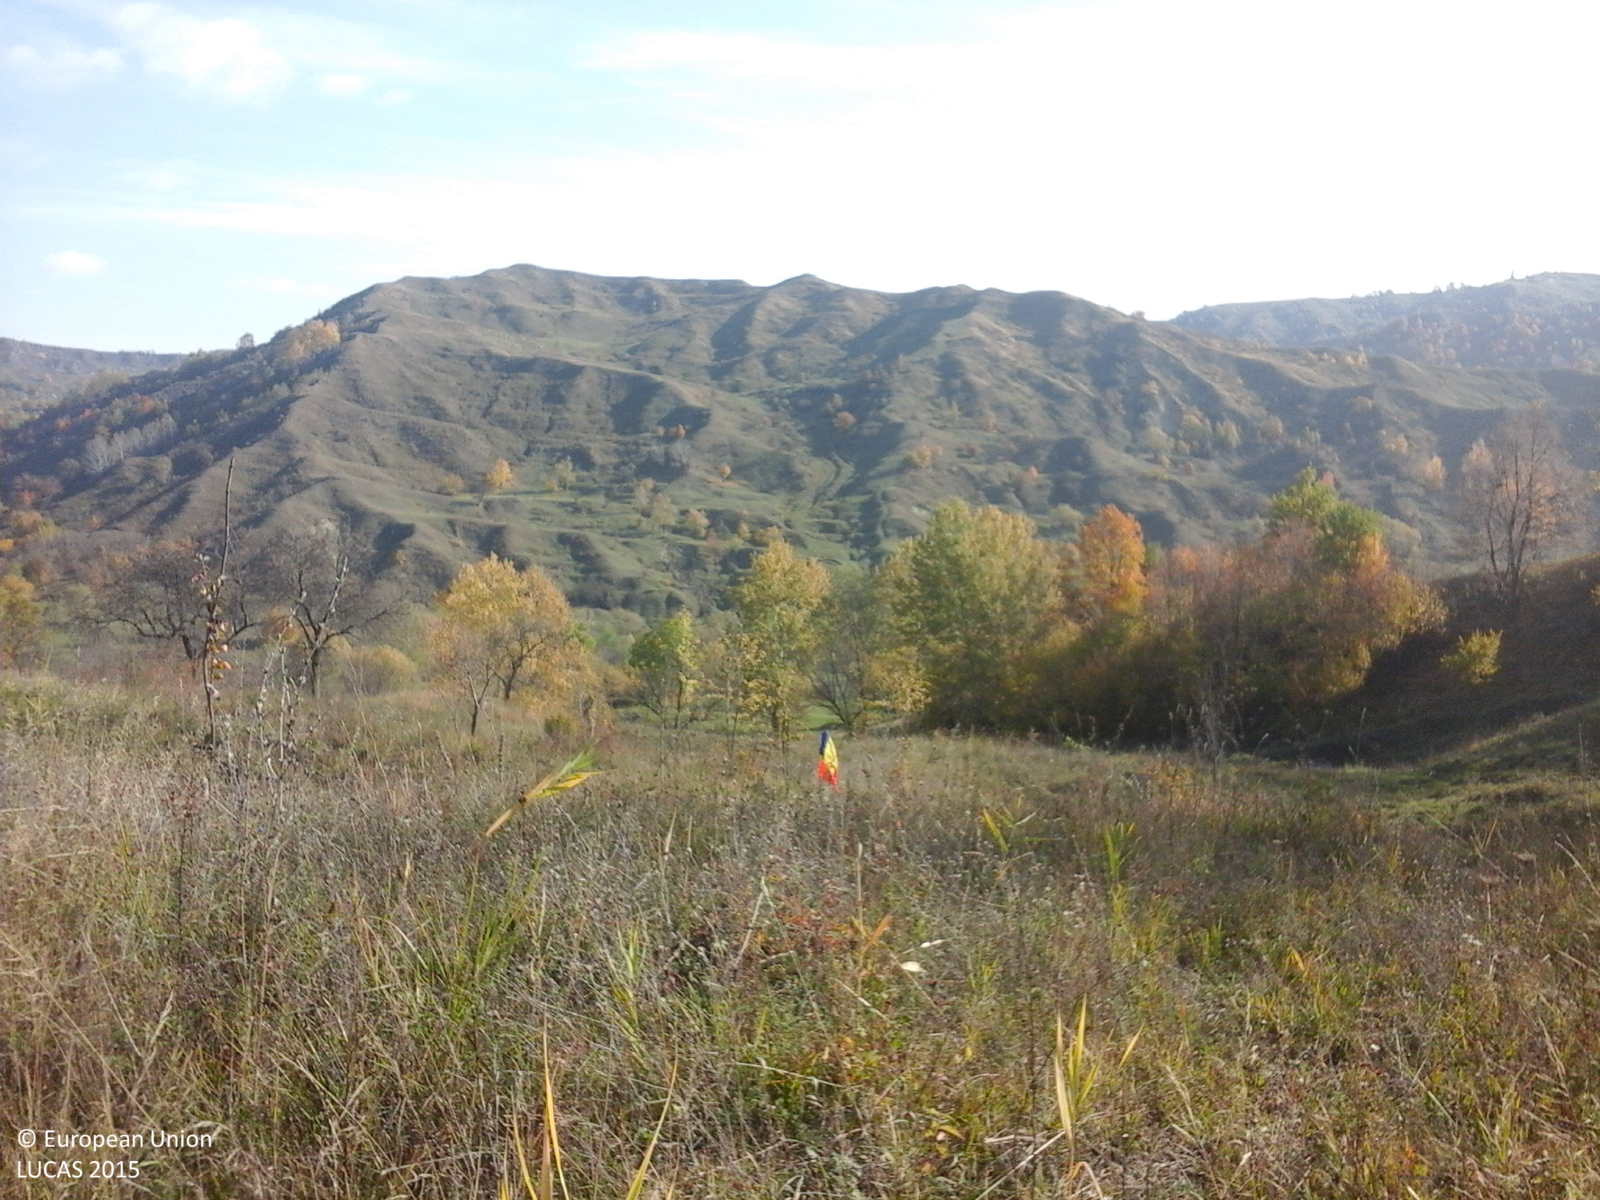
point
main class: Grassland
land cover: Grassland with sparse tree/shrub cover
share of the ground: > 75 %
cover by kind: herbaceous plants 85 %, shrubs 10 %, broadleaved forest trees 5 %
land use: Fallow land
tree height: < 5 m
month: October
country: RO
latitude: 45.6460
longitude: 26.9606
